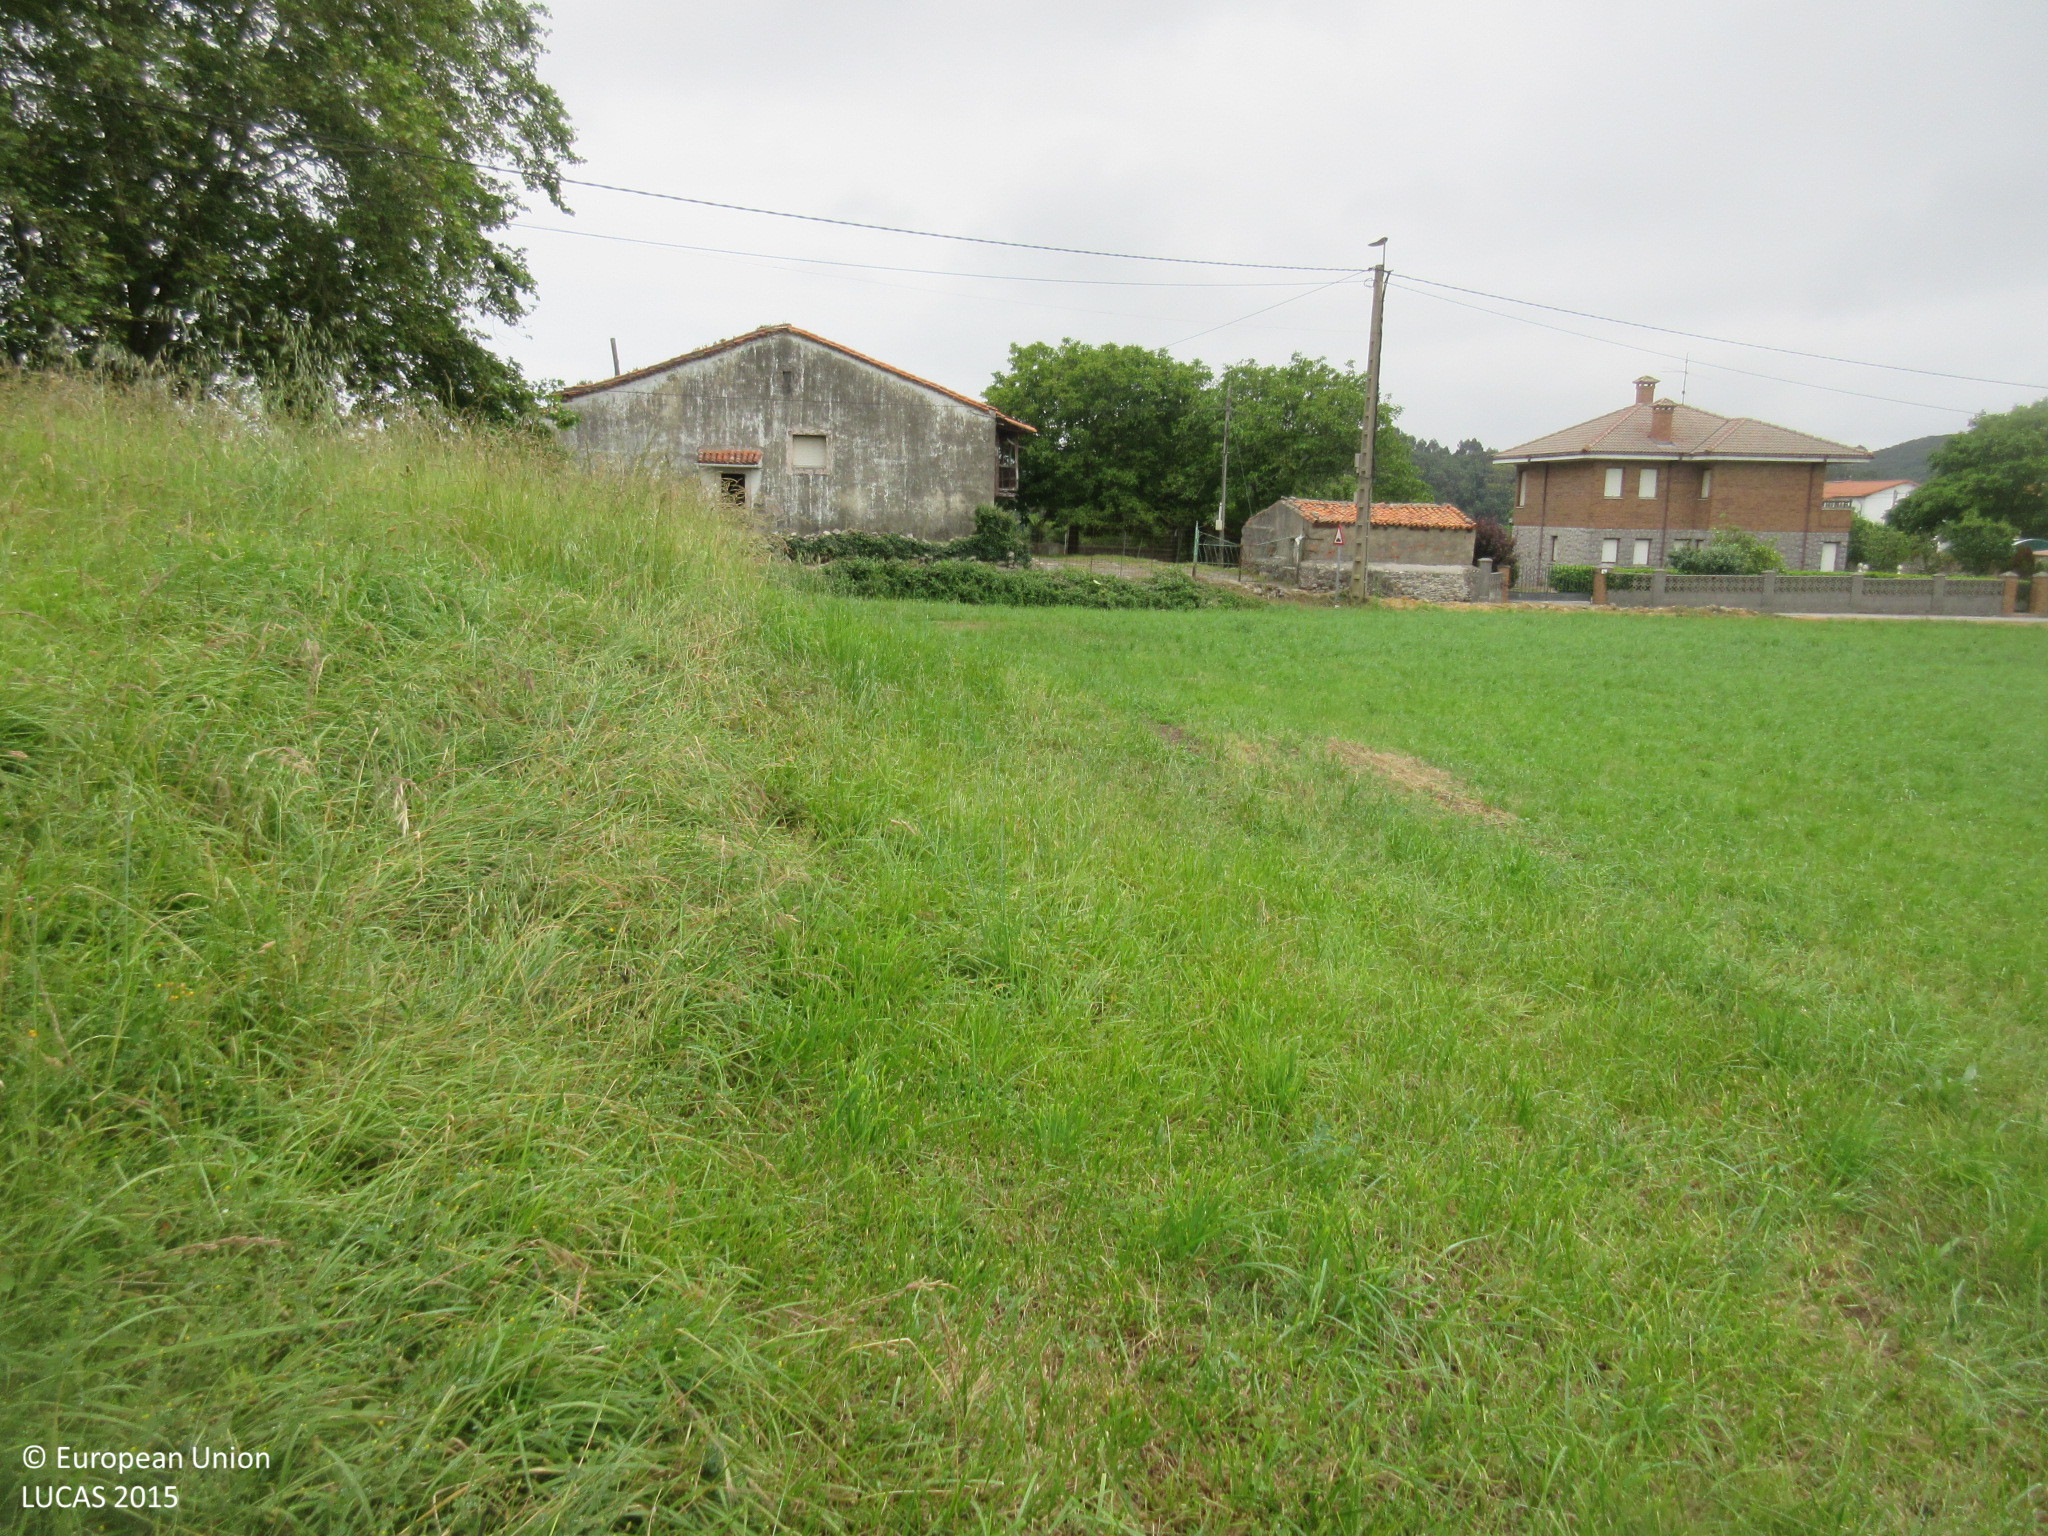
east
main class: Grassland
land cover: Grassland without tree/shrub cover
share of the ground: > 75 %
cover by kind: herbaceous plants 100 %
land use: Agriculture (excluding fallow land and kitchen gardens)
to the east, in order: Grassland without tree/shrub cover; Artificial constructions in urban areas; Grassland with sparse tree/shrub cover; Tracks; Fences; Grassland without tree/shrub cover; Shruby margins; Fences; Grassland without tree/shrub cover; Fences; Grassland without tree/shrub cover
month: June
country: ES
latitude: 43.4567
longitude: -3.5531
